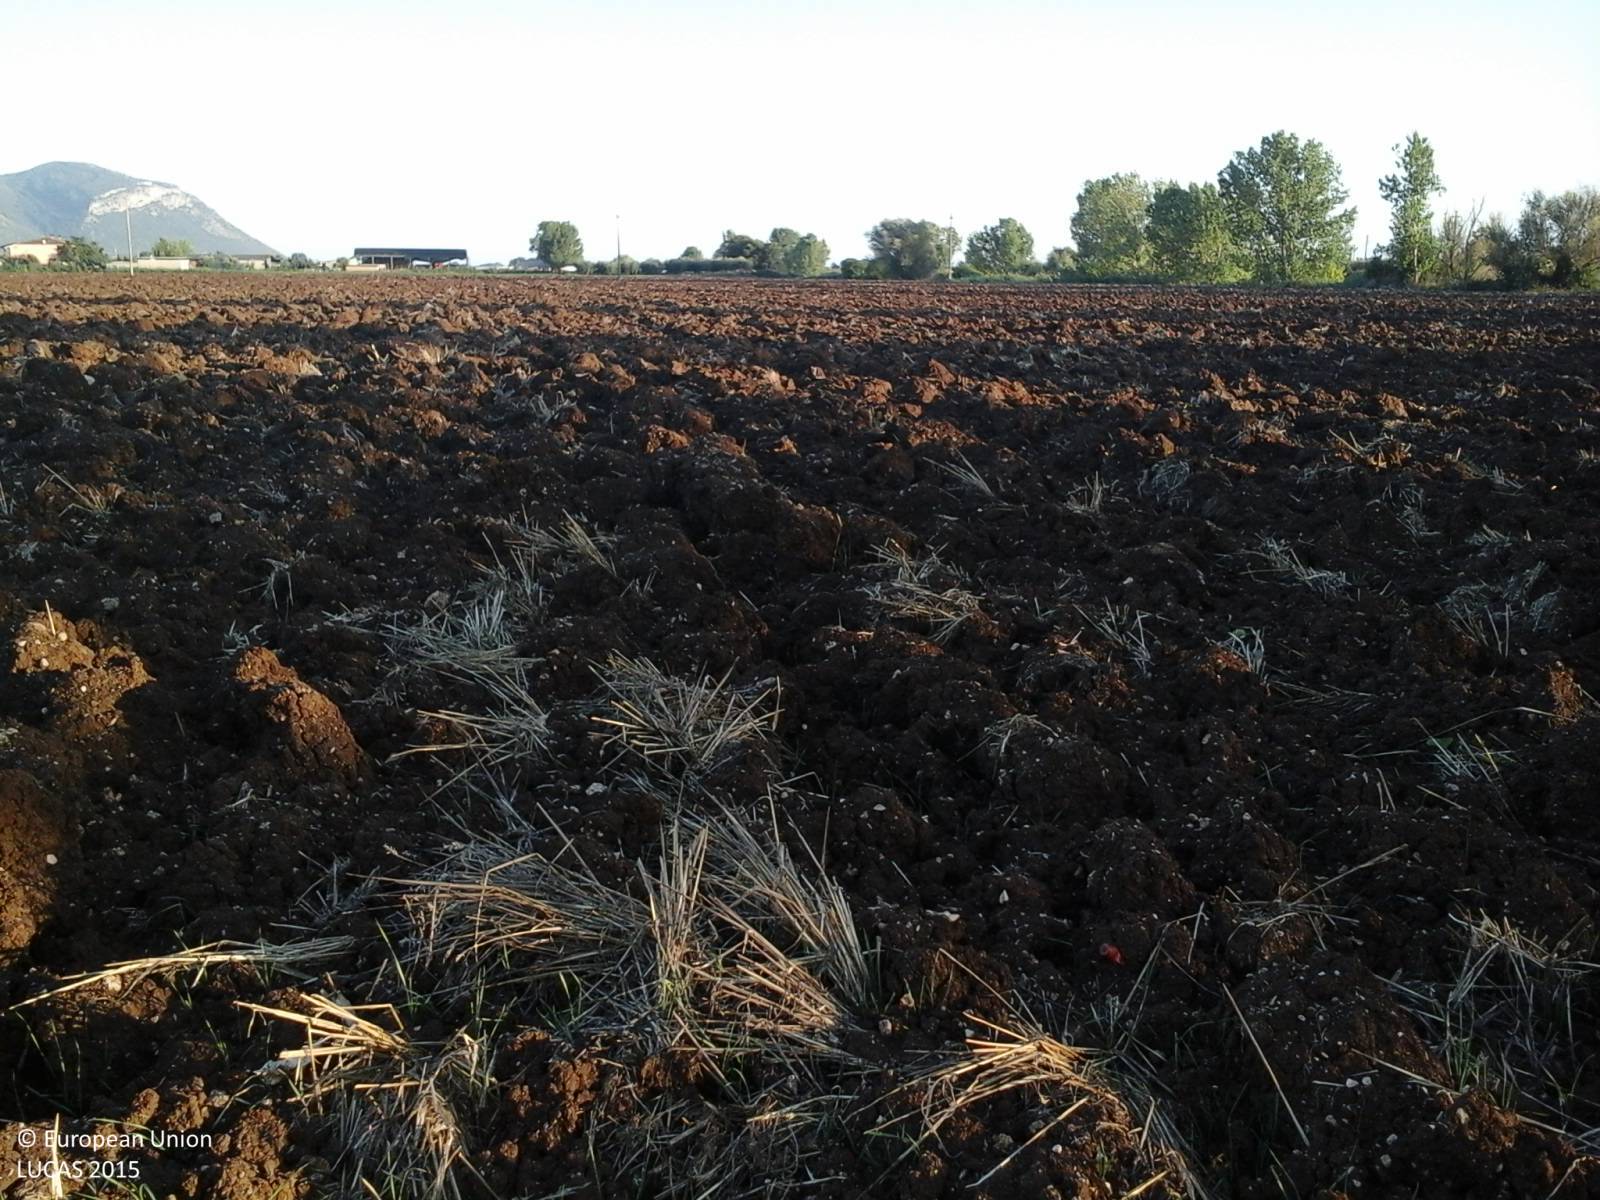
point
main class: Cropland
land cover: Common wheat
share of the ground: < 10 %
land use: Agriculture (excluding fallow land and kitchen gardens)
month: August
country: IT
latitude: 41.3752
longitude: 13.1558
